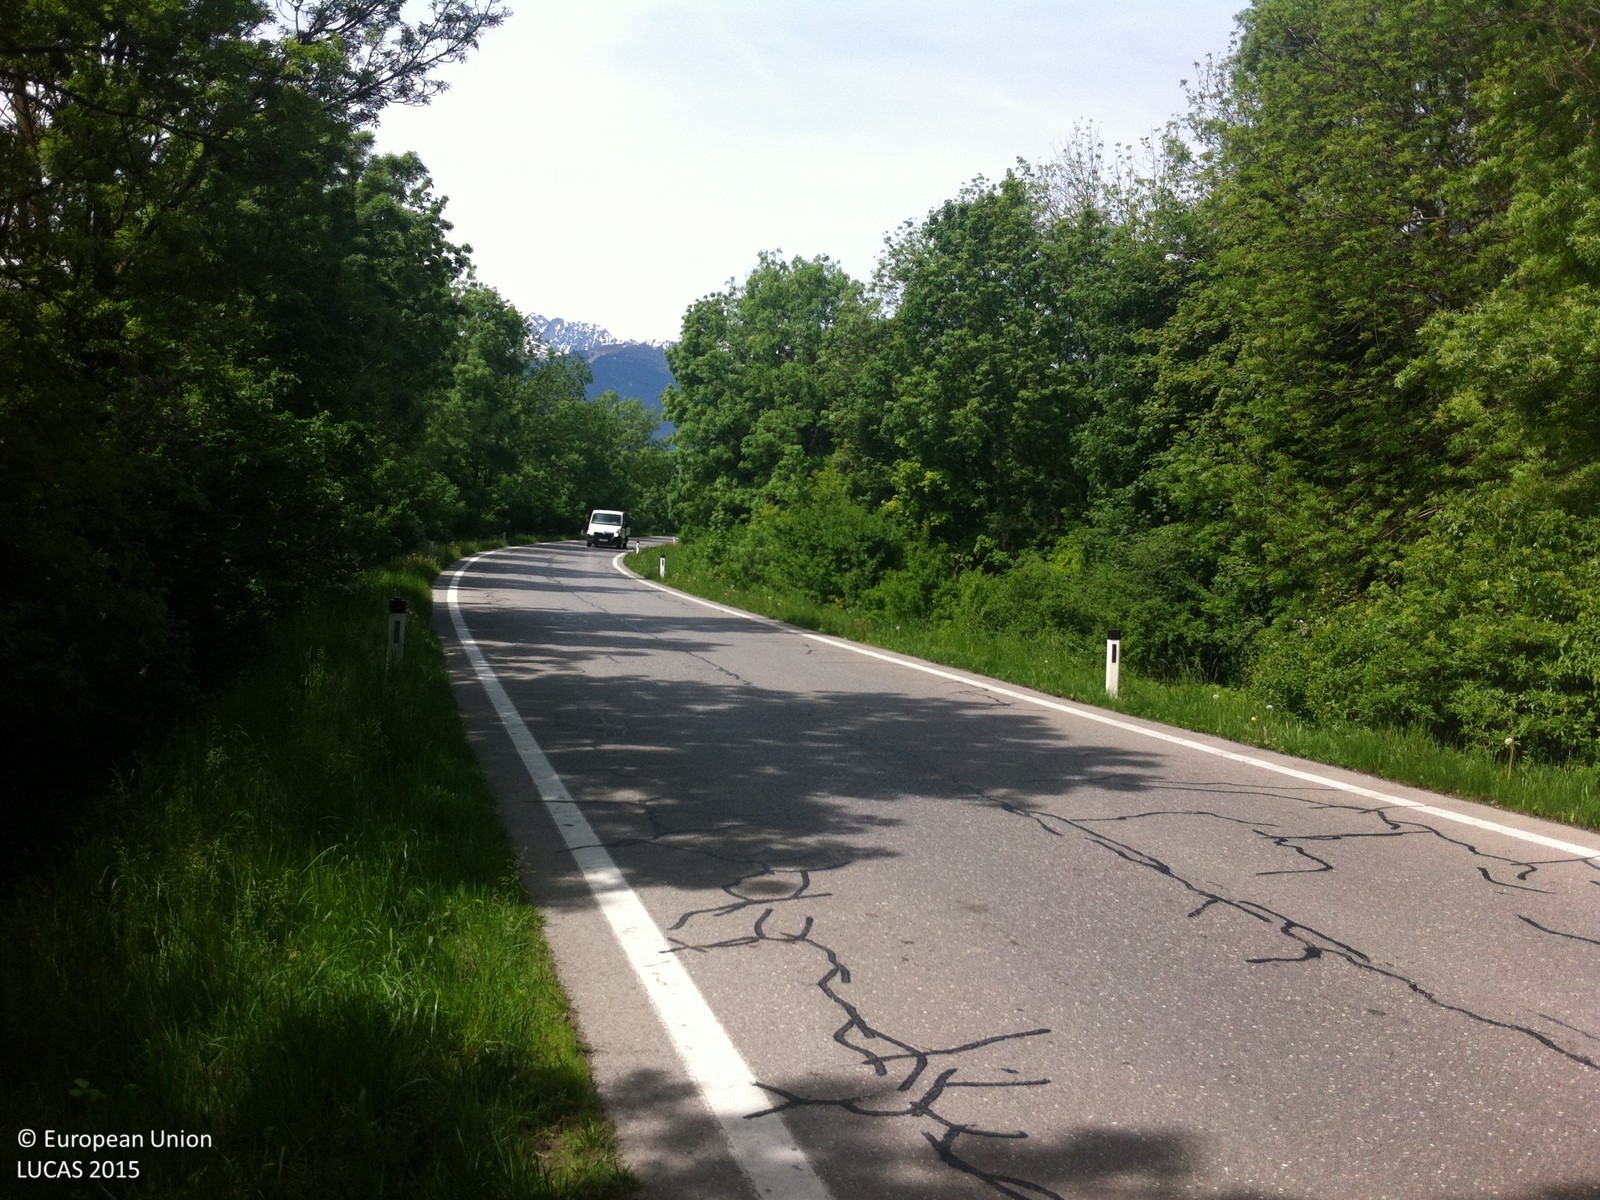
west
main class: Woodland
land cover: Broadleaved woodland
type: mesophytic deciduous forest
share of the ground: > 75 %
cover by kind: broadleaved forest trees 100 %
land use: Semi-natural and natural areas not in use
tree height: > 5 m
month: May
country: AT
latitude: 47.2614
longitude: 11.3336
